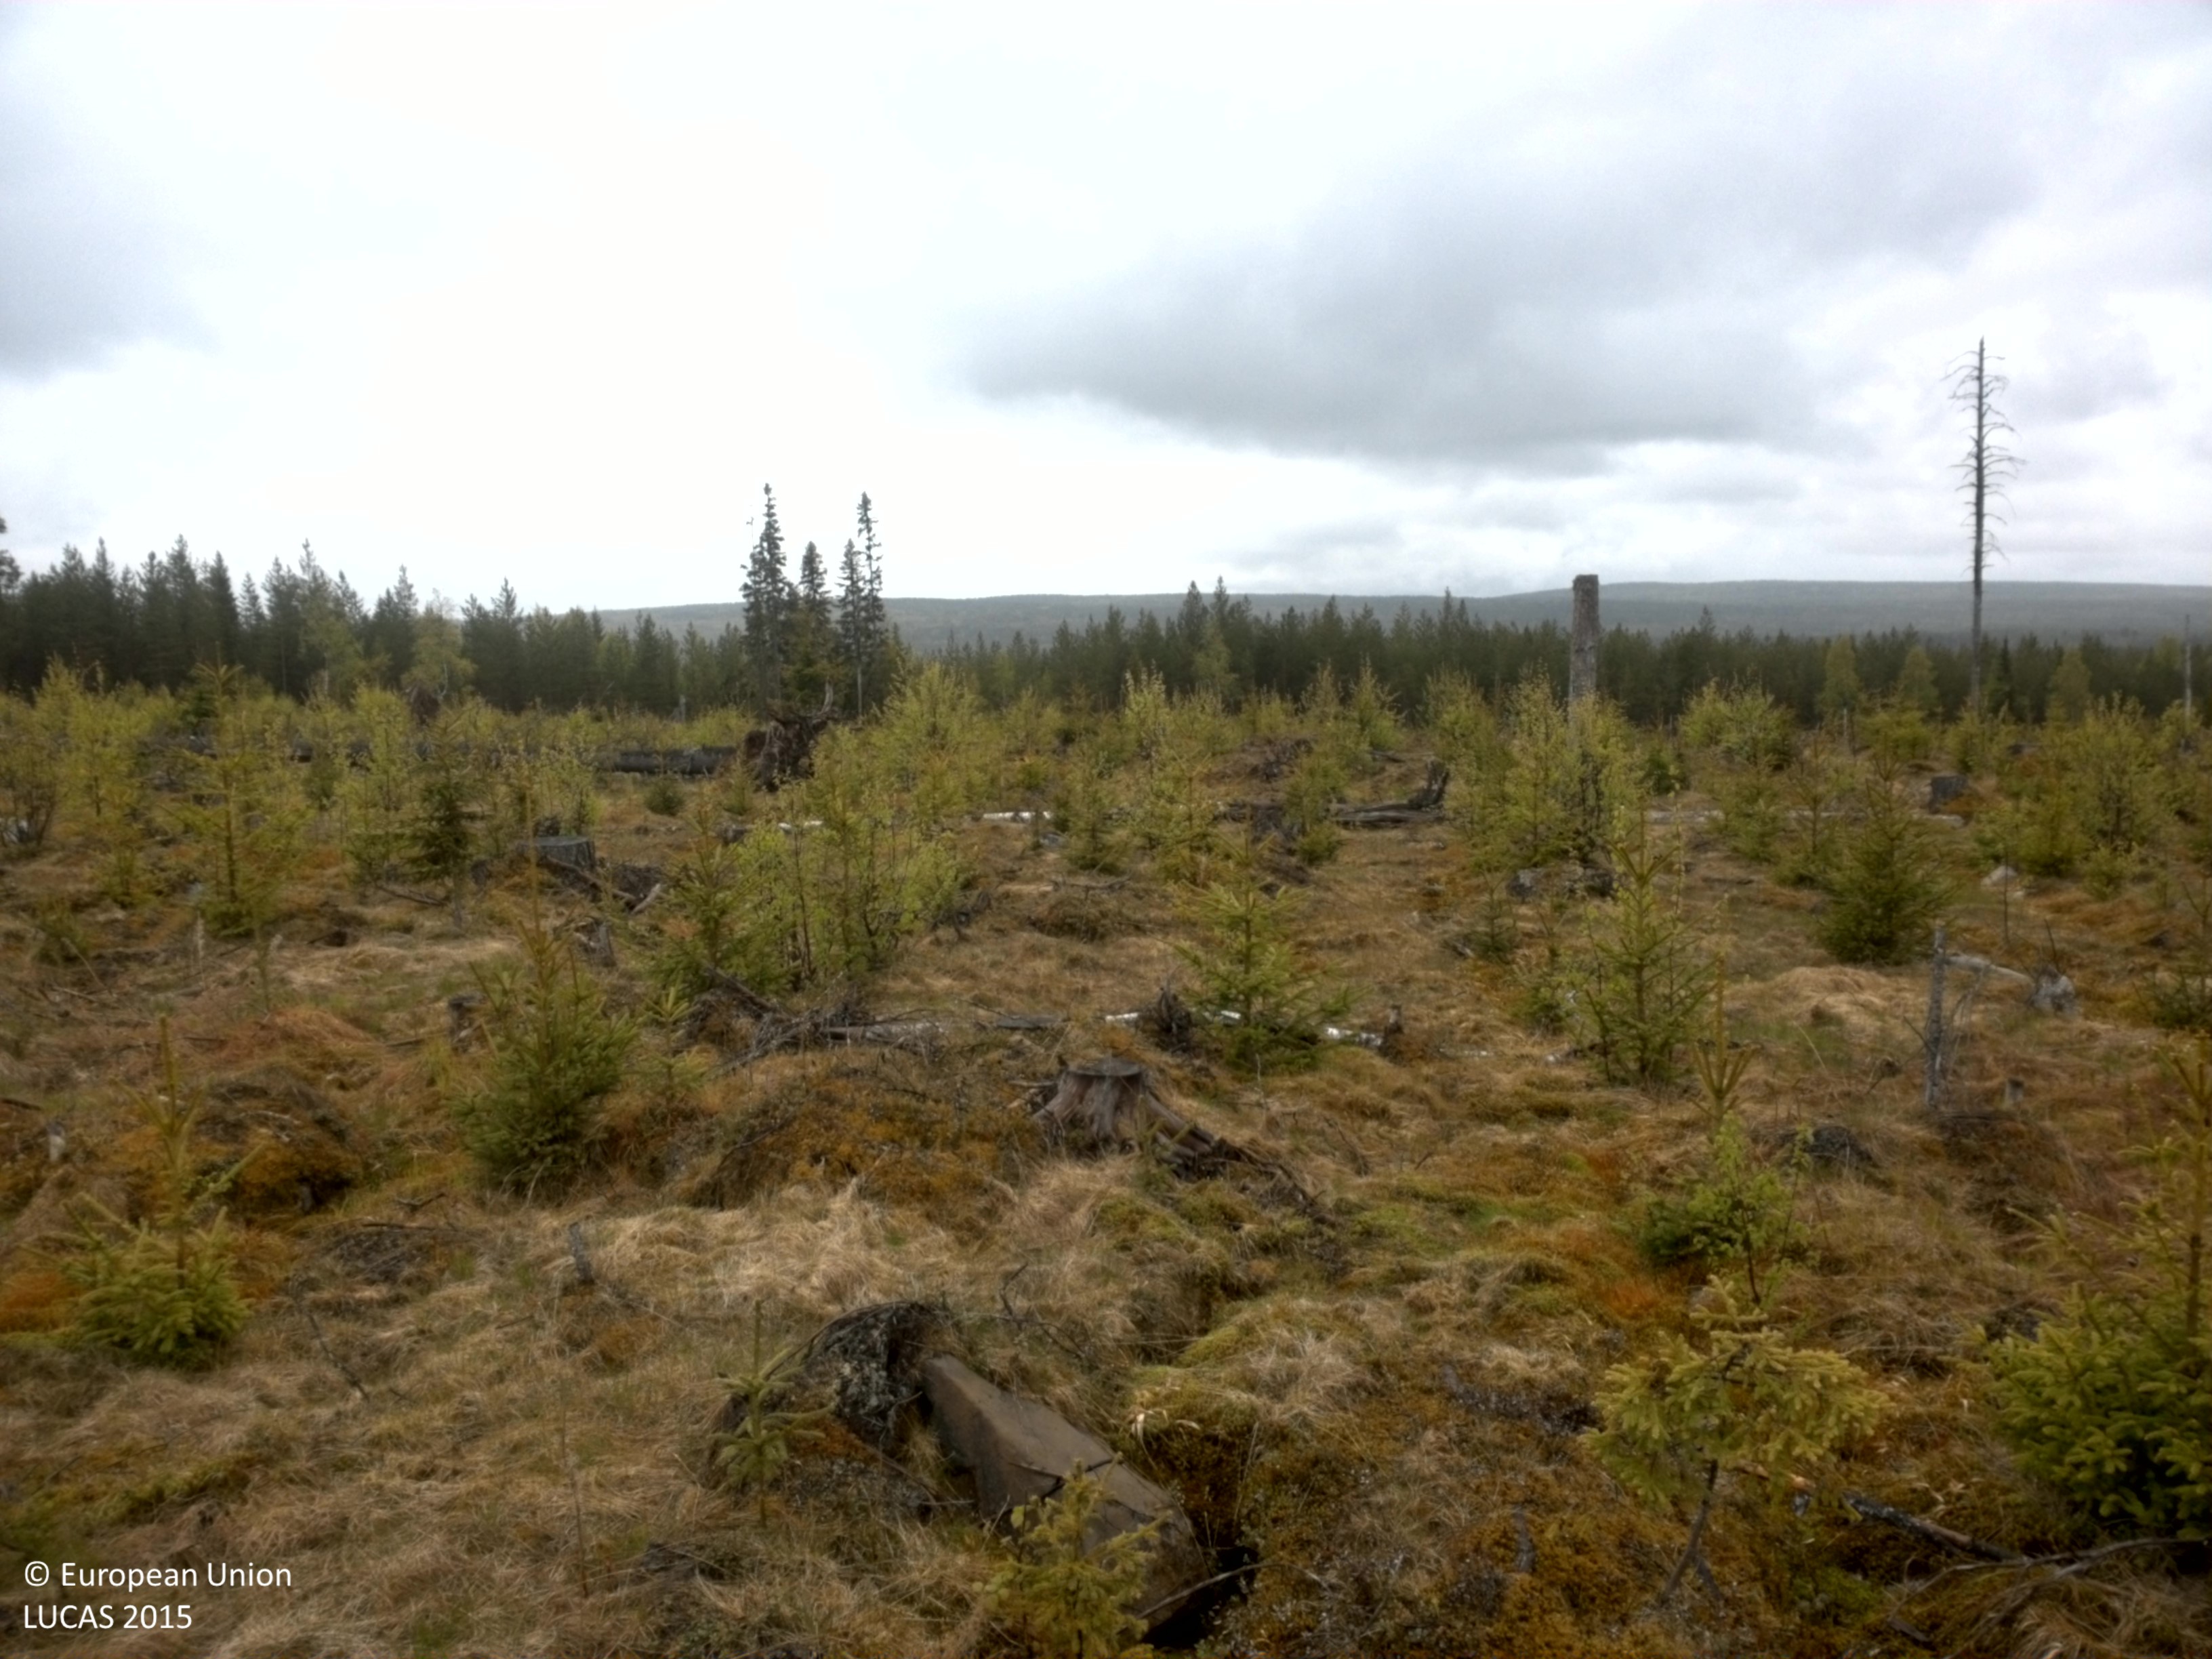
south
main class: Woodland
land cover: Spruce dominated coniferous woodland
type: boreal forest
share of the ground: 10 - 25 %
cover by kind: herbaceous plants 40 %, lichens and mosses 30 %, coniferous forest trees 15 %, broadleaved forest trees 5 %, shrubs 5 %, unconsolidated bare surface 5 %
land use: Forestry
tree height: < 5 m
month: June
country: SE
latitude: 64.4043
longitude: 17.4571
